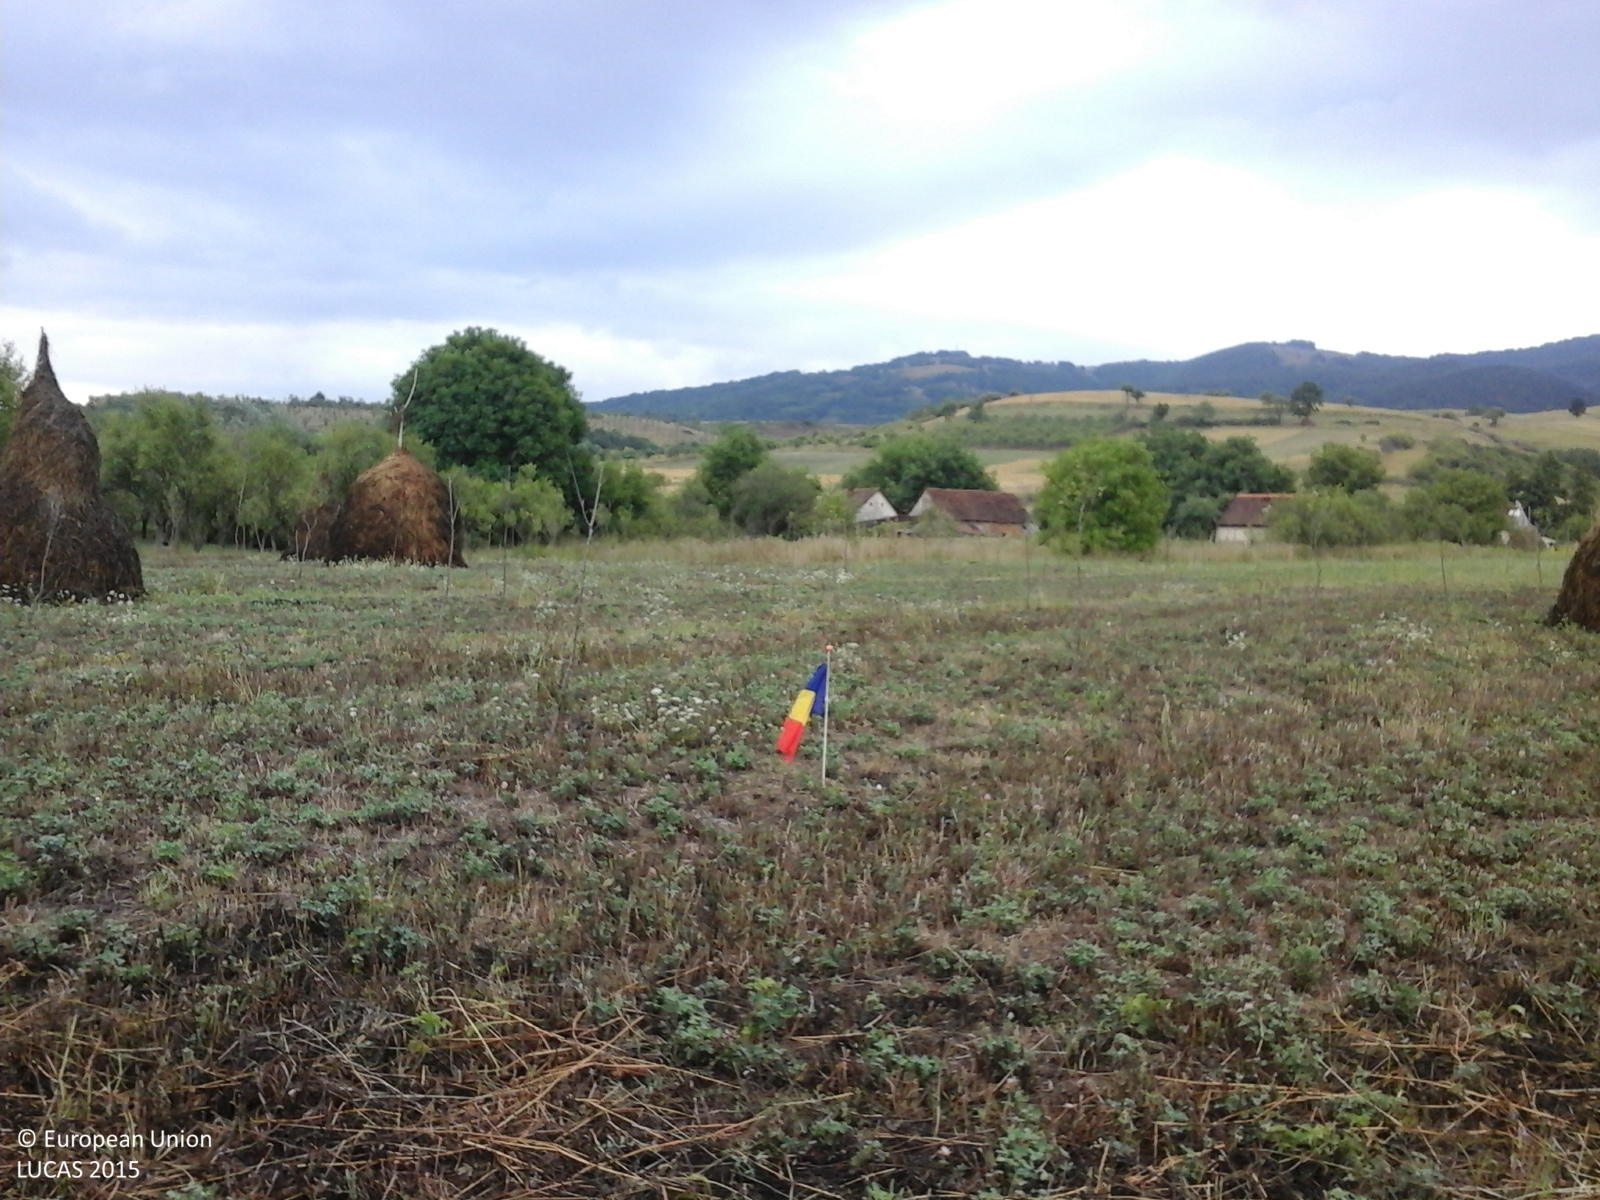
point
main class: Cropland
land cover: Apple fruit
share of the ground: > 75 %
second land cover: Lucerne
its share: > 75 %
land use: Agriculture (excluding fallow land and kitchen gardens)
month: August
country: RO
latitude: 44.8603
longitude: 21.9421
